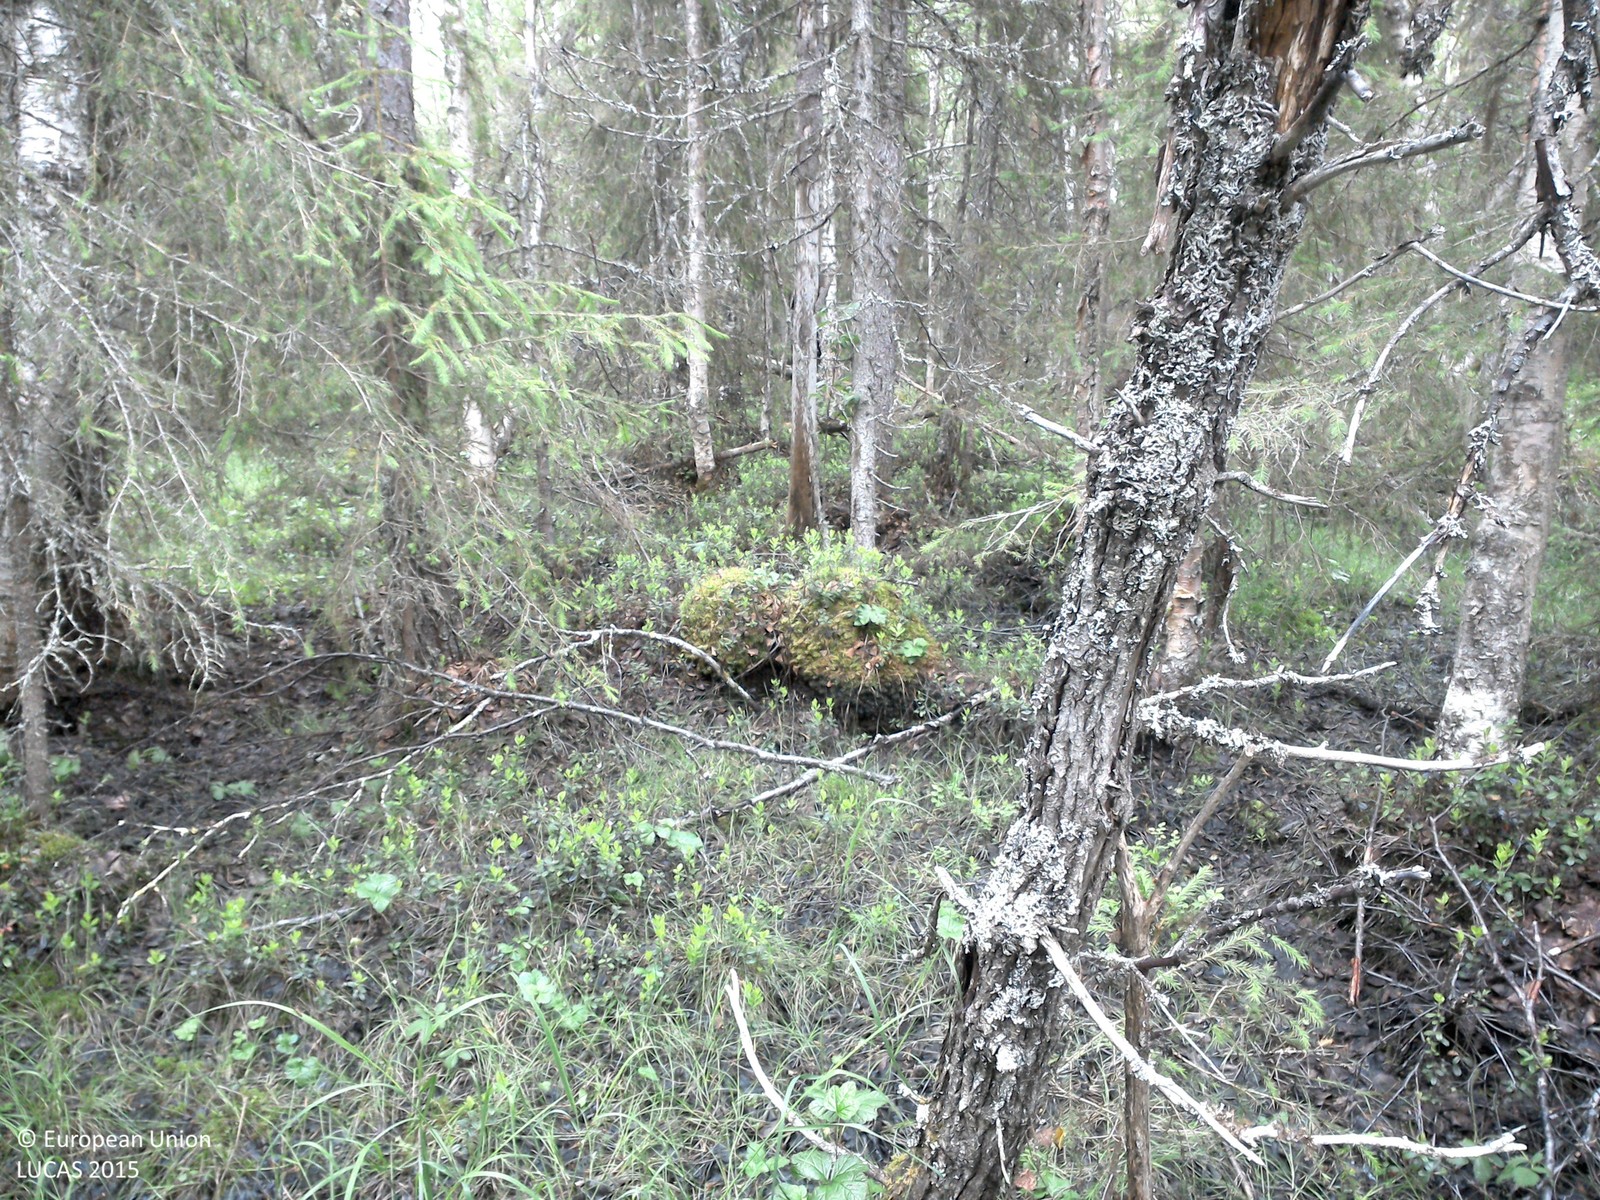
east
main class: Woodland
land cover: Spruce dominated mixed woodland
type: boreal forest
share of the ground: 25 - 50 %
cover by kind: shrubs 35 %, coniferous forest trees 25 %, broadleaved forest trees 15 %, herbaceous plants 15 %, lichens and mosses 10 %
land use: Forestry
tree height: > 5 m
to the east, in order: Spruce dominated mixed woodland; Ditches and canals; Spruce dominated mixed woodland; Spruce dominated coniferous woodland; Pine dominated mixed woodland
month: July
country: SE
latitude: 66.8482
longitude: 23.8186
